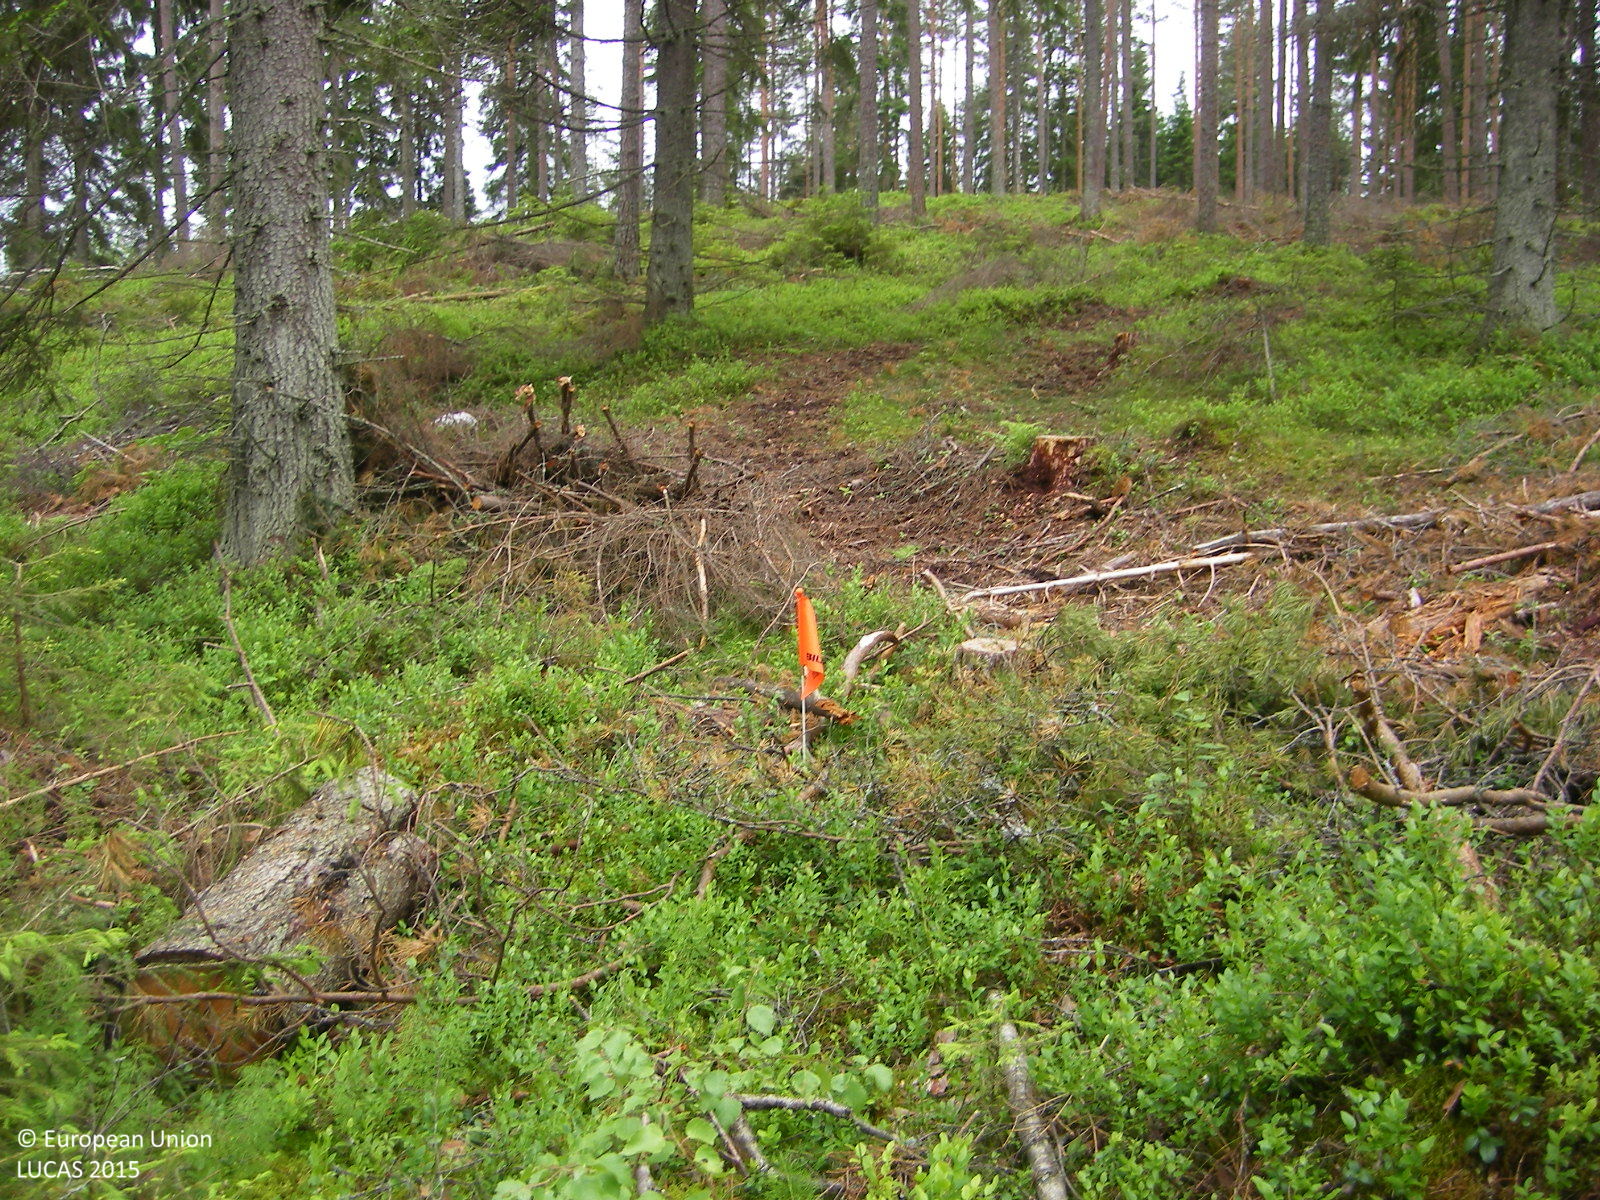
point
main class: Woodland
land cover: Other coniferous woodland
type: boreal forest
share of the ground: 50 - 75 %
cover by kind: coniferous forest trees 60 %, shrubs 25 %, unconsolidated bare surface 10 %, lichens and mosses 5 %
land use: Forestry
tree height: > 5 m
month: June
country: FI
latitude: 60.2434
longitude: 23.2887
